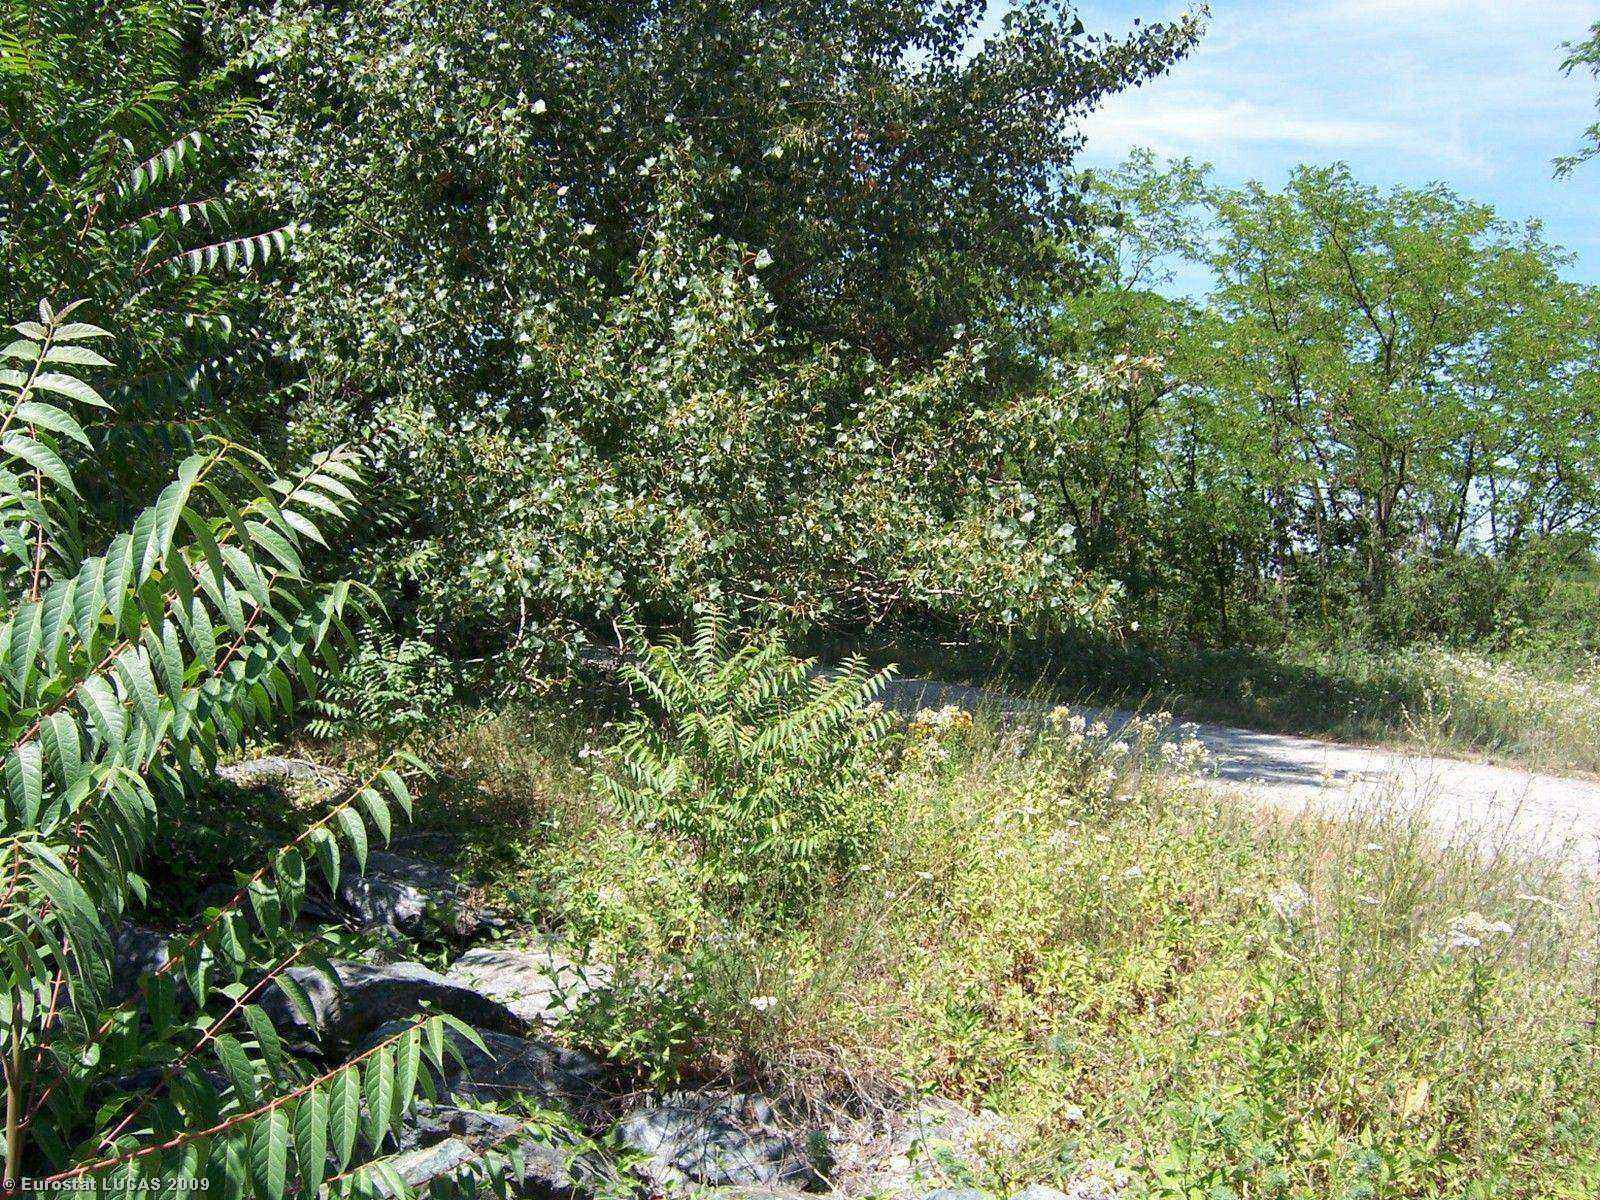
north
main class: Woodland
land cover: Broadleaved woodland
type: floodplain forest
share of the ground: > 75 %
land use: Unused
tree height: > 5 m
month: July
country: IT
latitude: 44.8235
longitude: 7.4121
